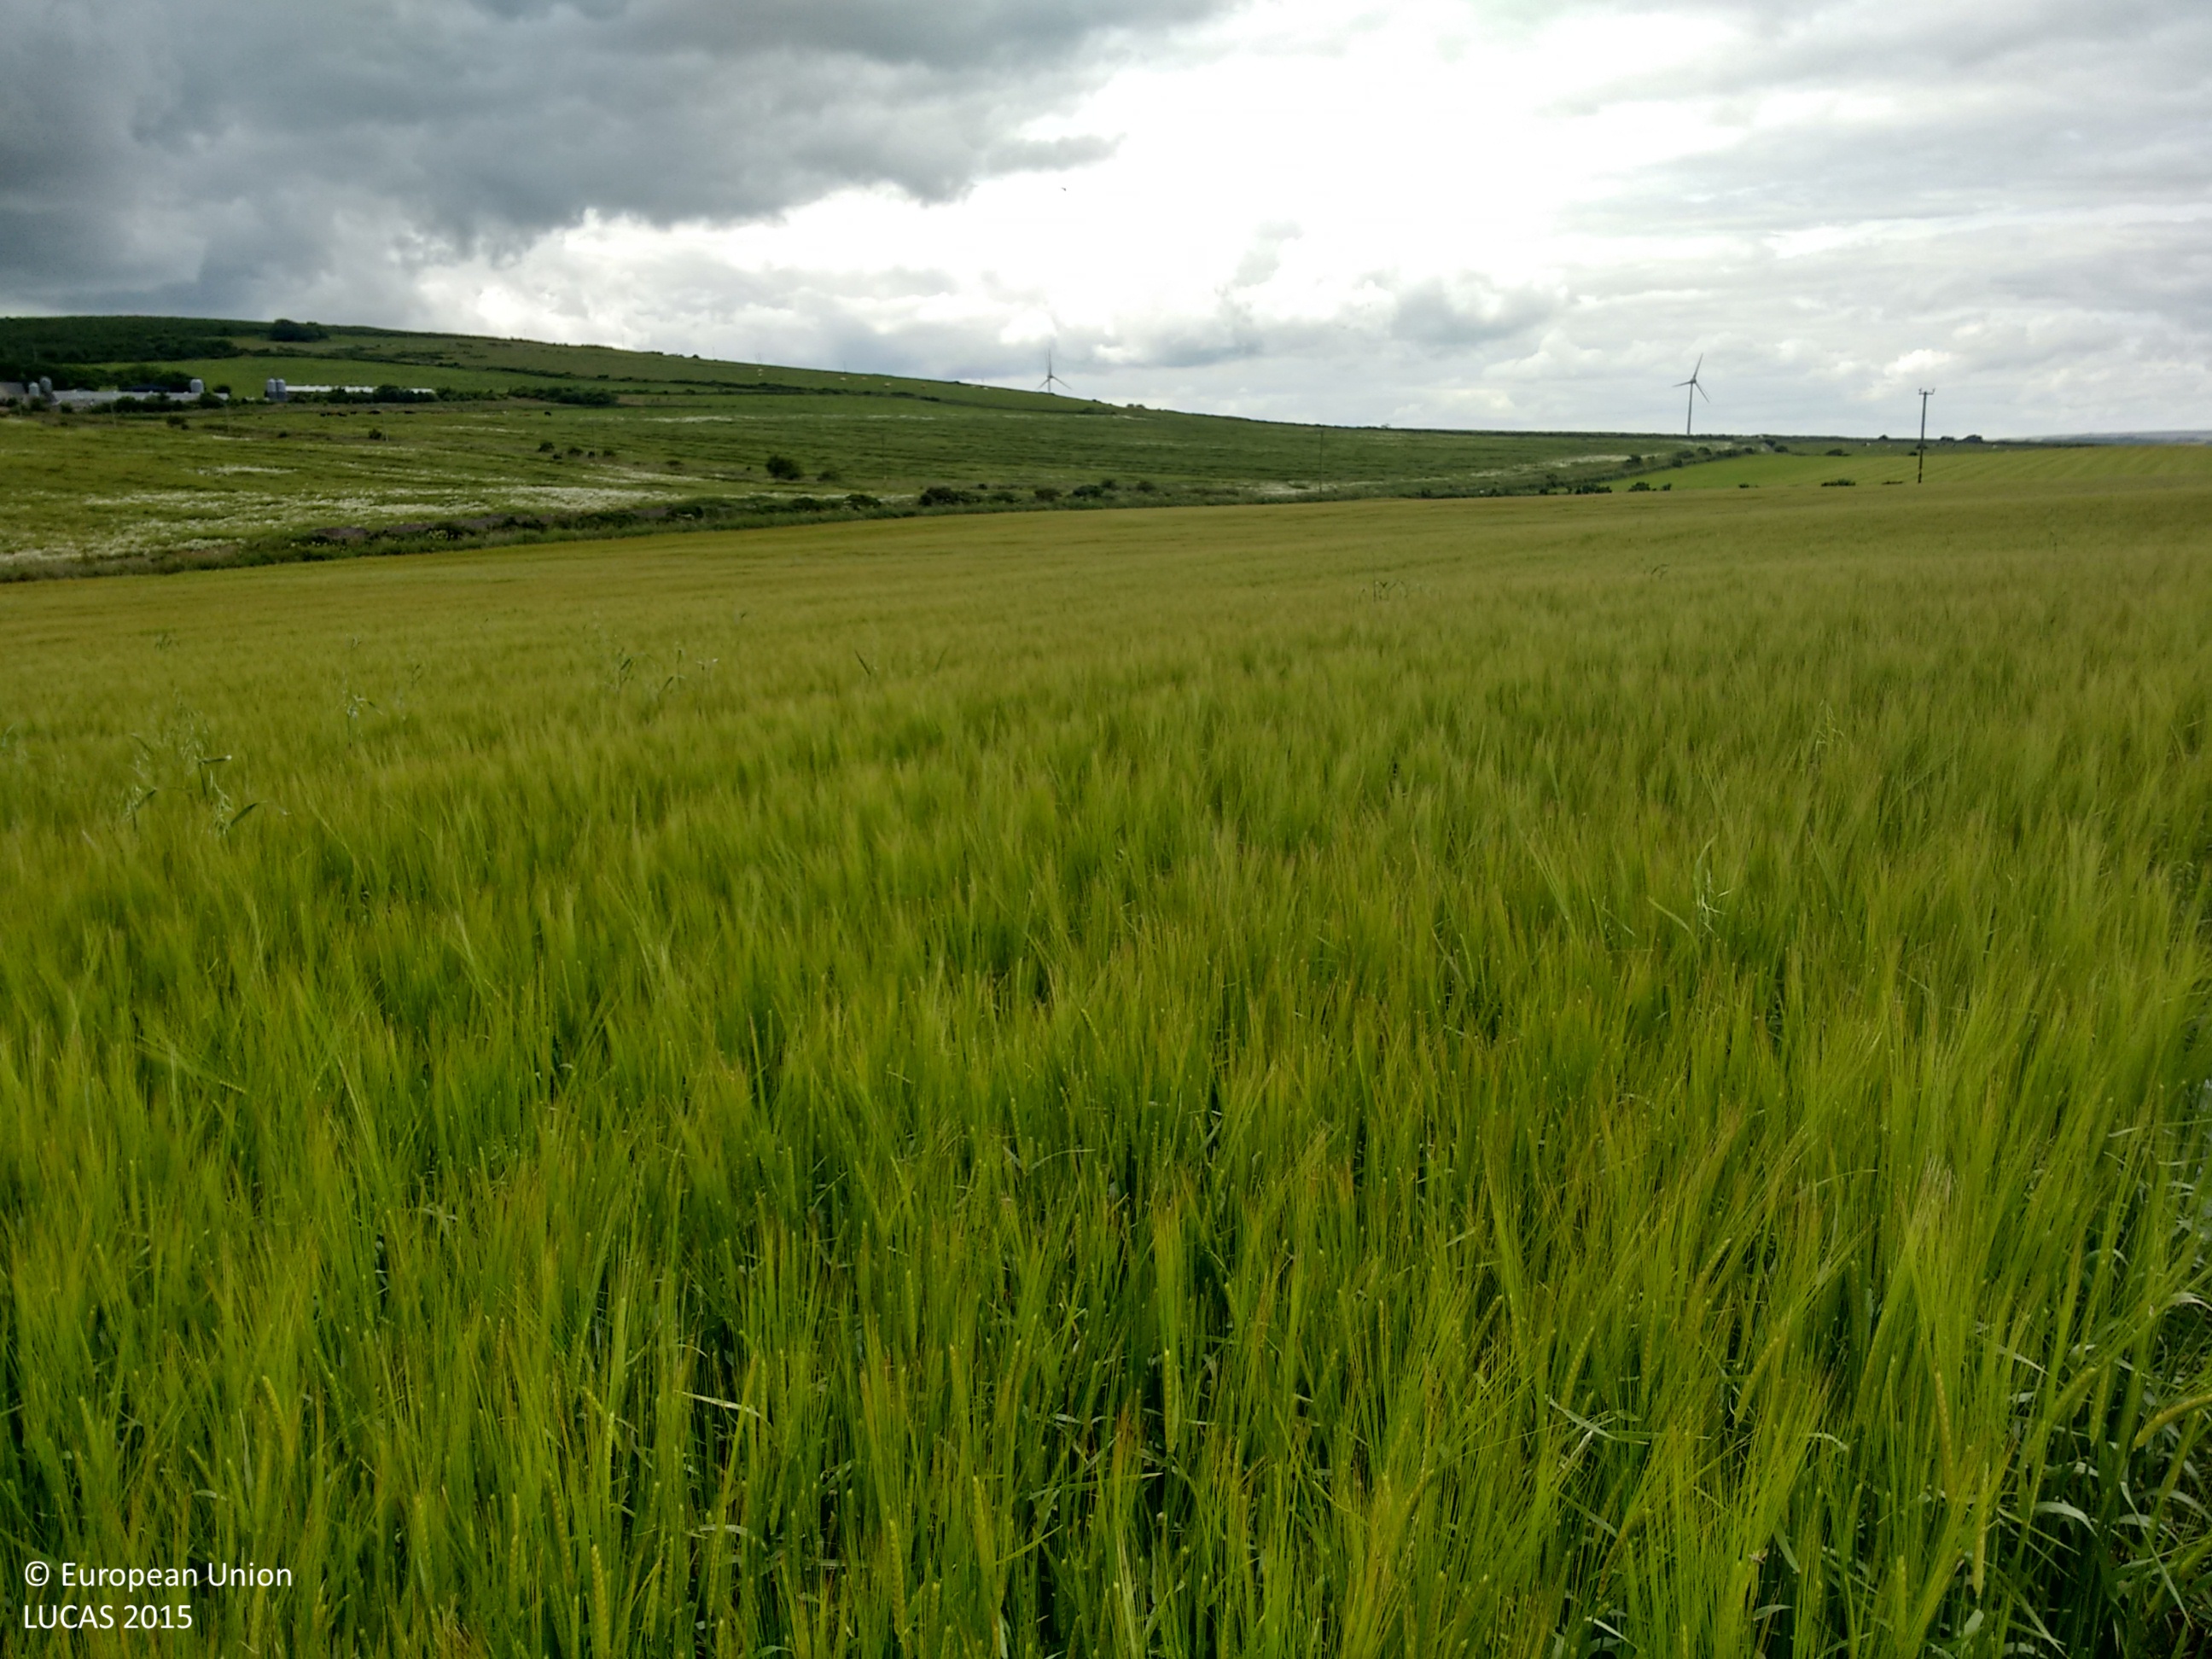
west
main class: Cropland
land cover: Barley
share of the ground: > 75 %
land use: Agriculture (excluding fallow land and kitchen gardens)
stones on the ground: < 10 %
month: July
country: GB
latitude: 57.6234
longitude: -2.0165
